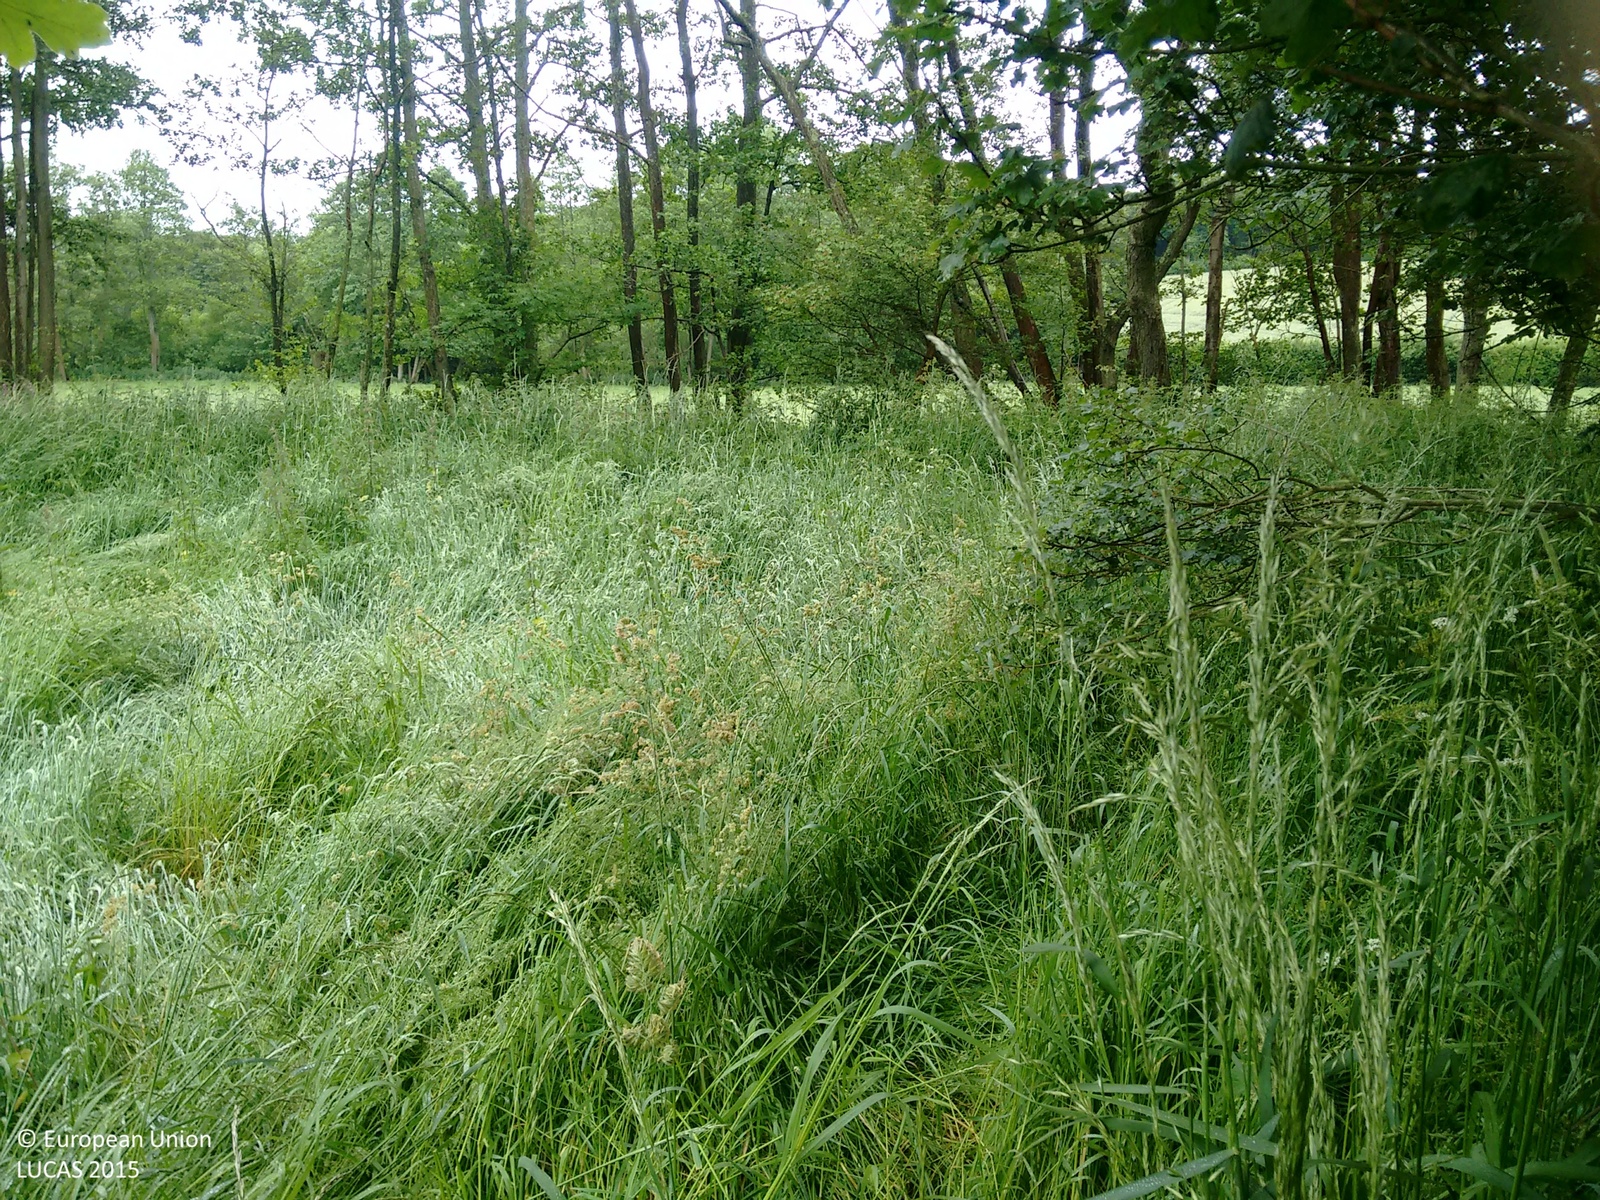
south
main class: Grassland
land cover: Grassland without tree/shrub cover
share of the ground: > 75 %
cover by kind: herbaceous plants 100 %
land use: Agriculture (excluding fallow land and kitchen gardens)
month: June
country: GB
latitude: 51.0235
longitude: 0.3473
